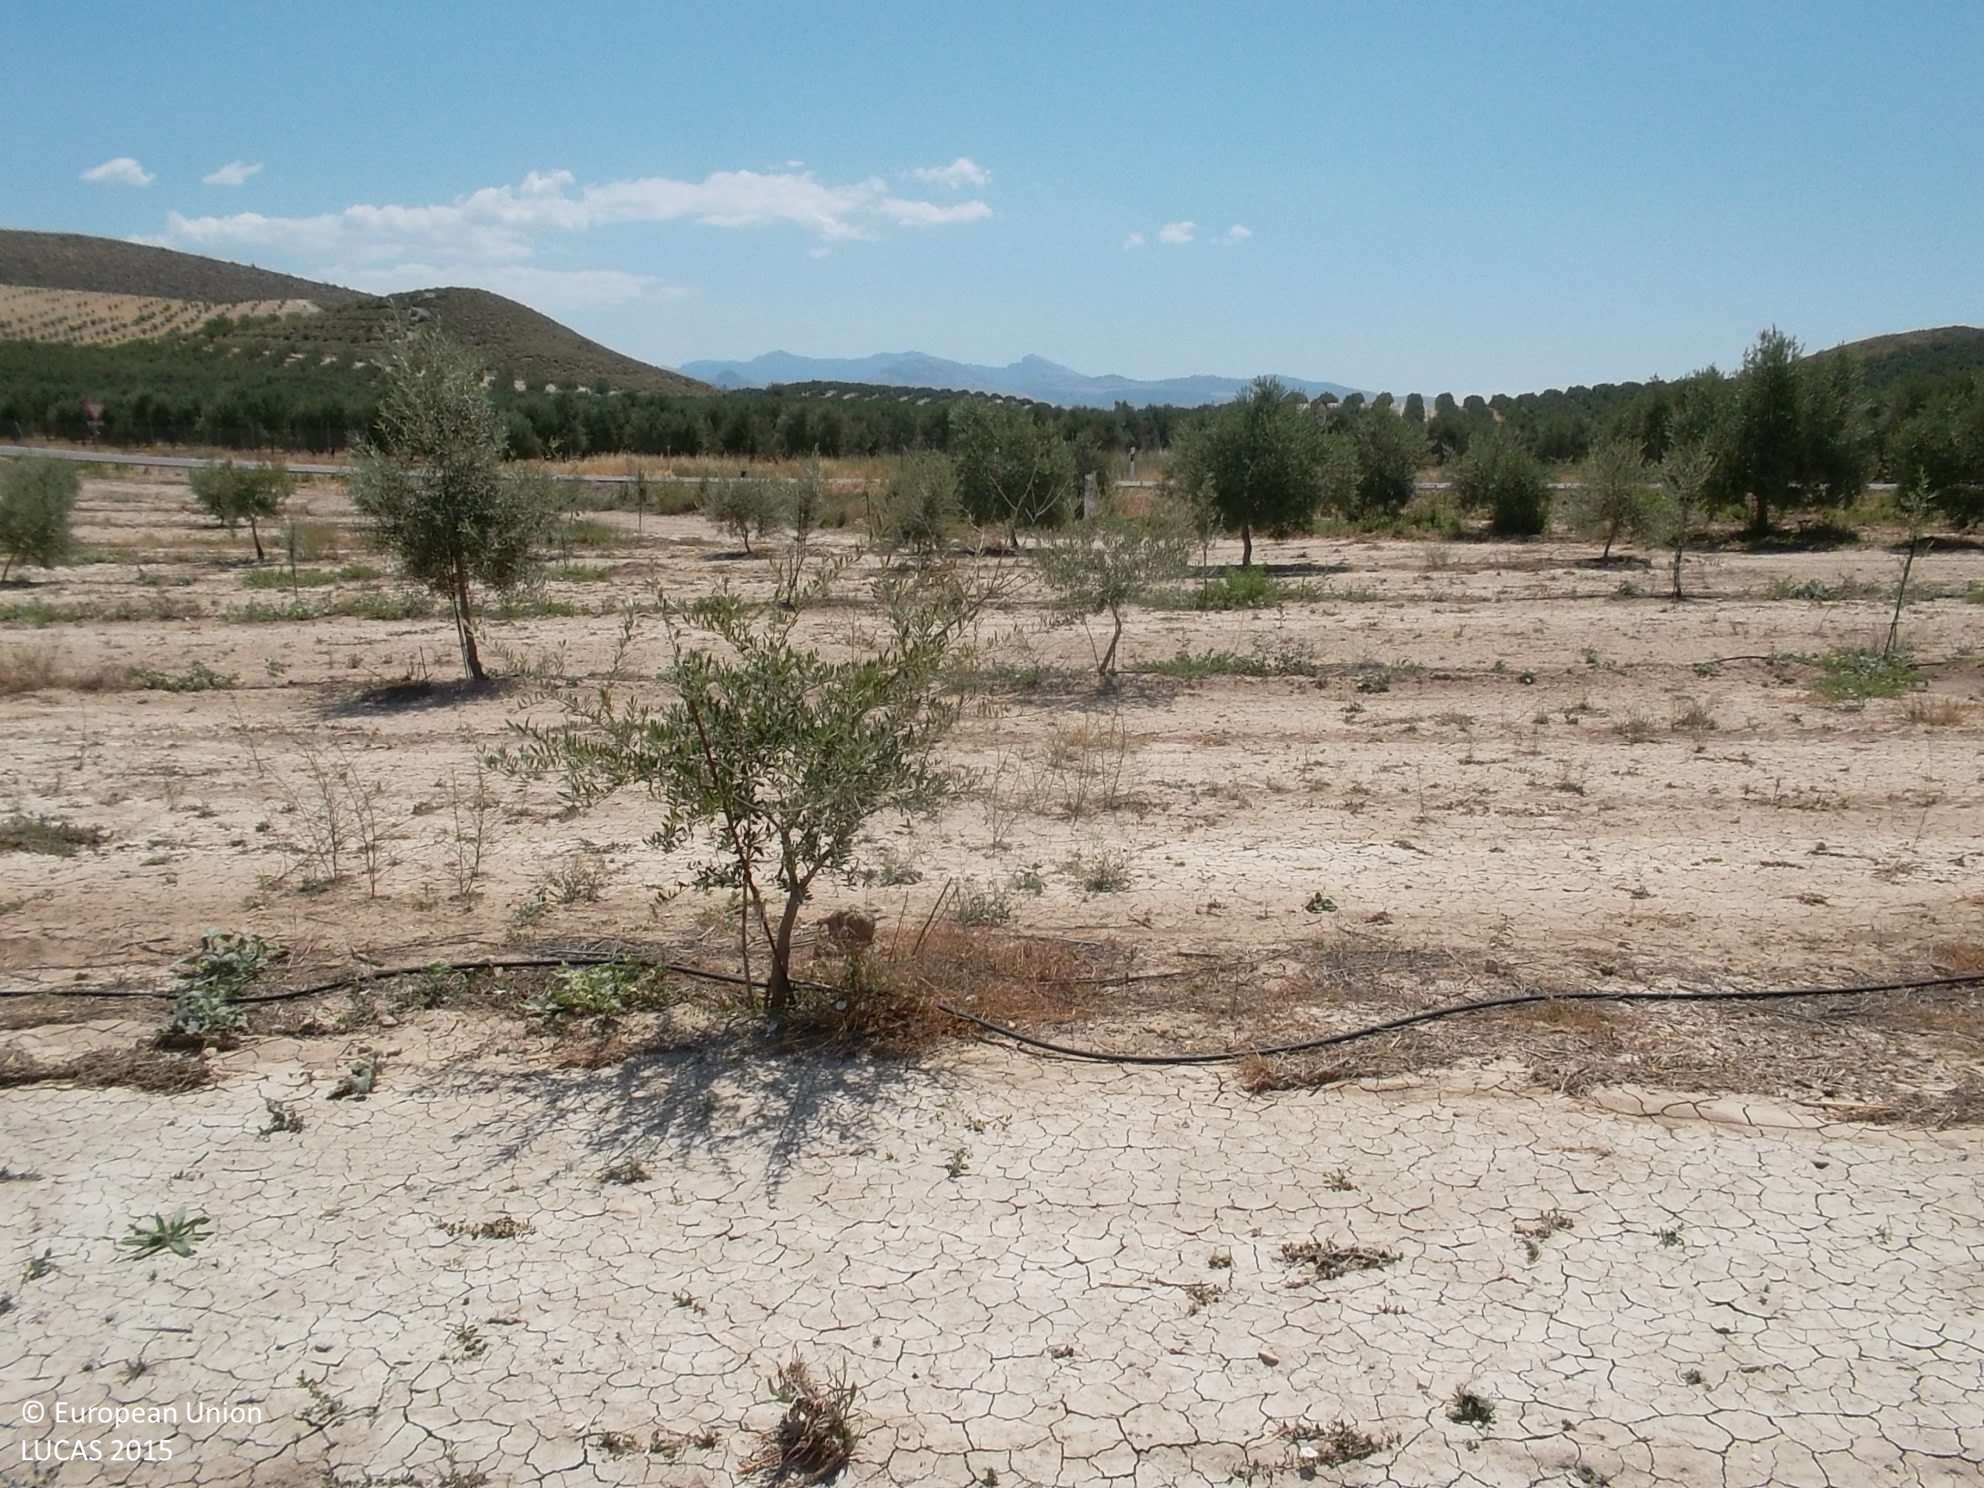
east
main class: Cropland
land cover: Olive groves
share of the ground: 25 - 50 %
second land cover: Other bare soil
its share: > 75 %
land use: Agriculture (excluding fallow land and kitchen gardens)
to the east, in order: Olive groves; Other bare soil; Ditches and canals; Grass margins; Paved roads, cycling and walking lanes; Grassland without tree/shrub cover; Fences; Olive groves
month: June
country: ES
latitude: 37.8454
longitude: -3.2354
